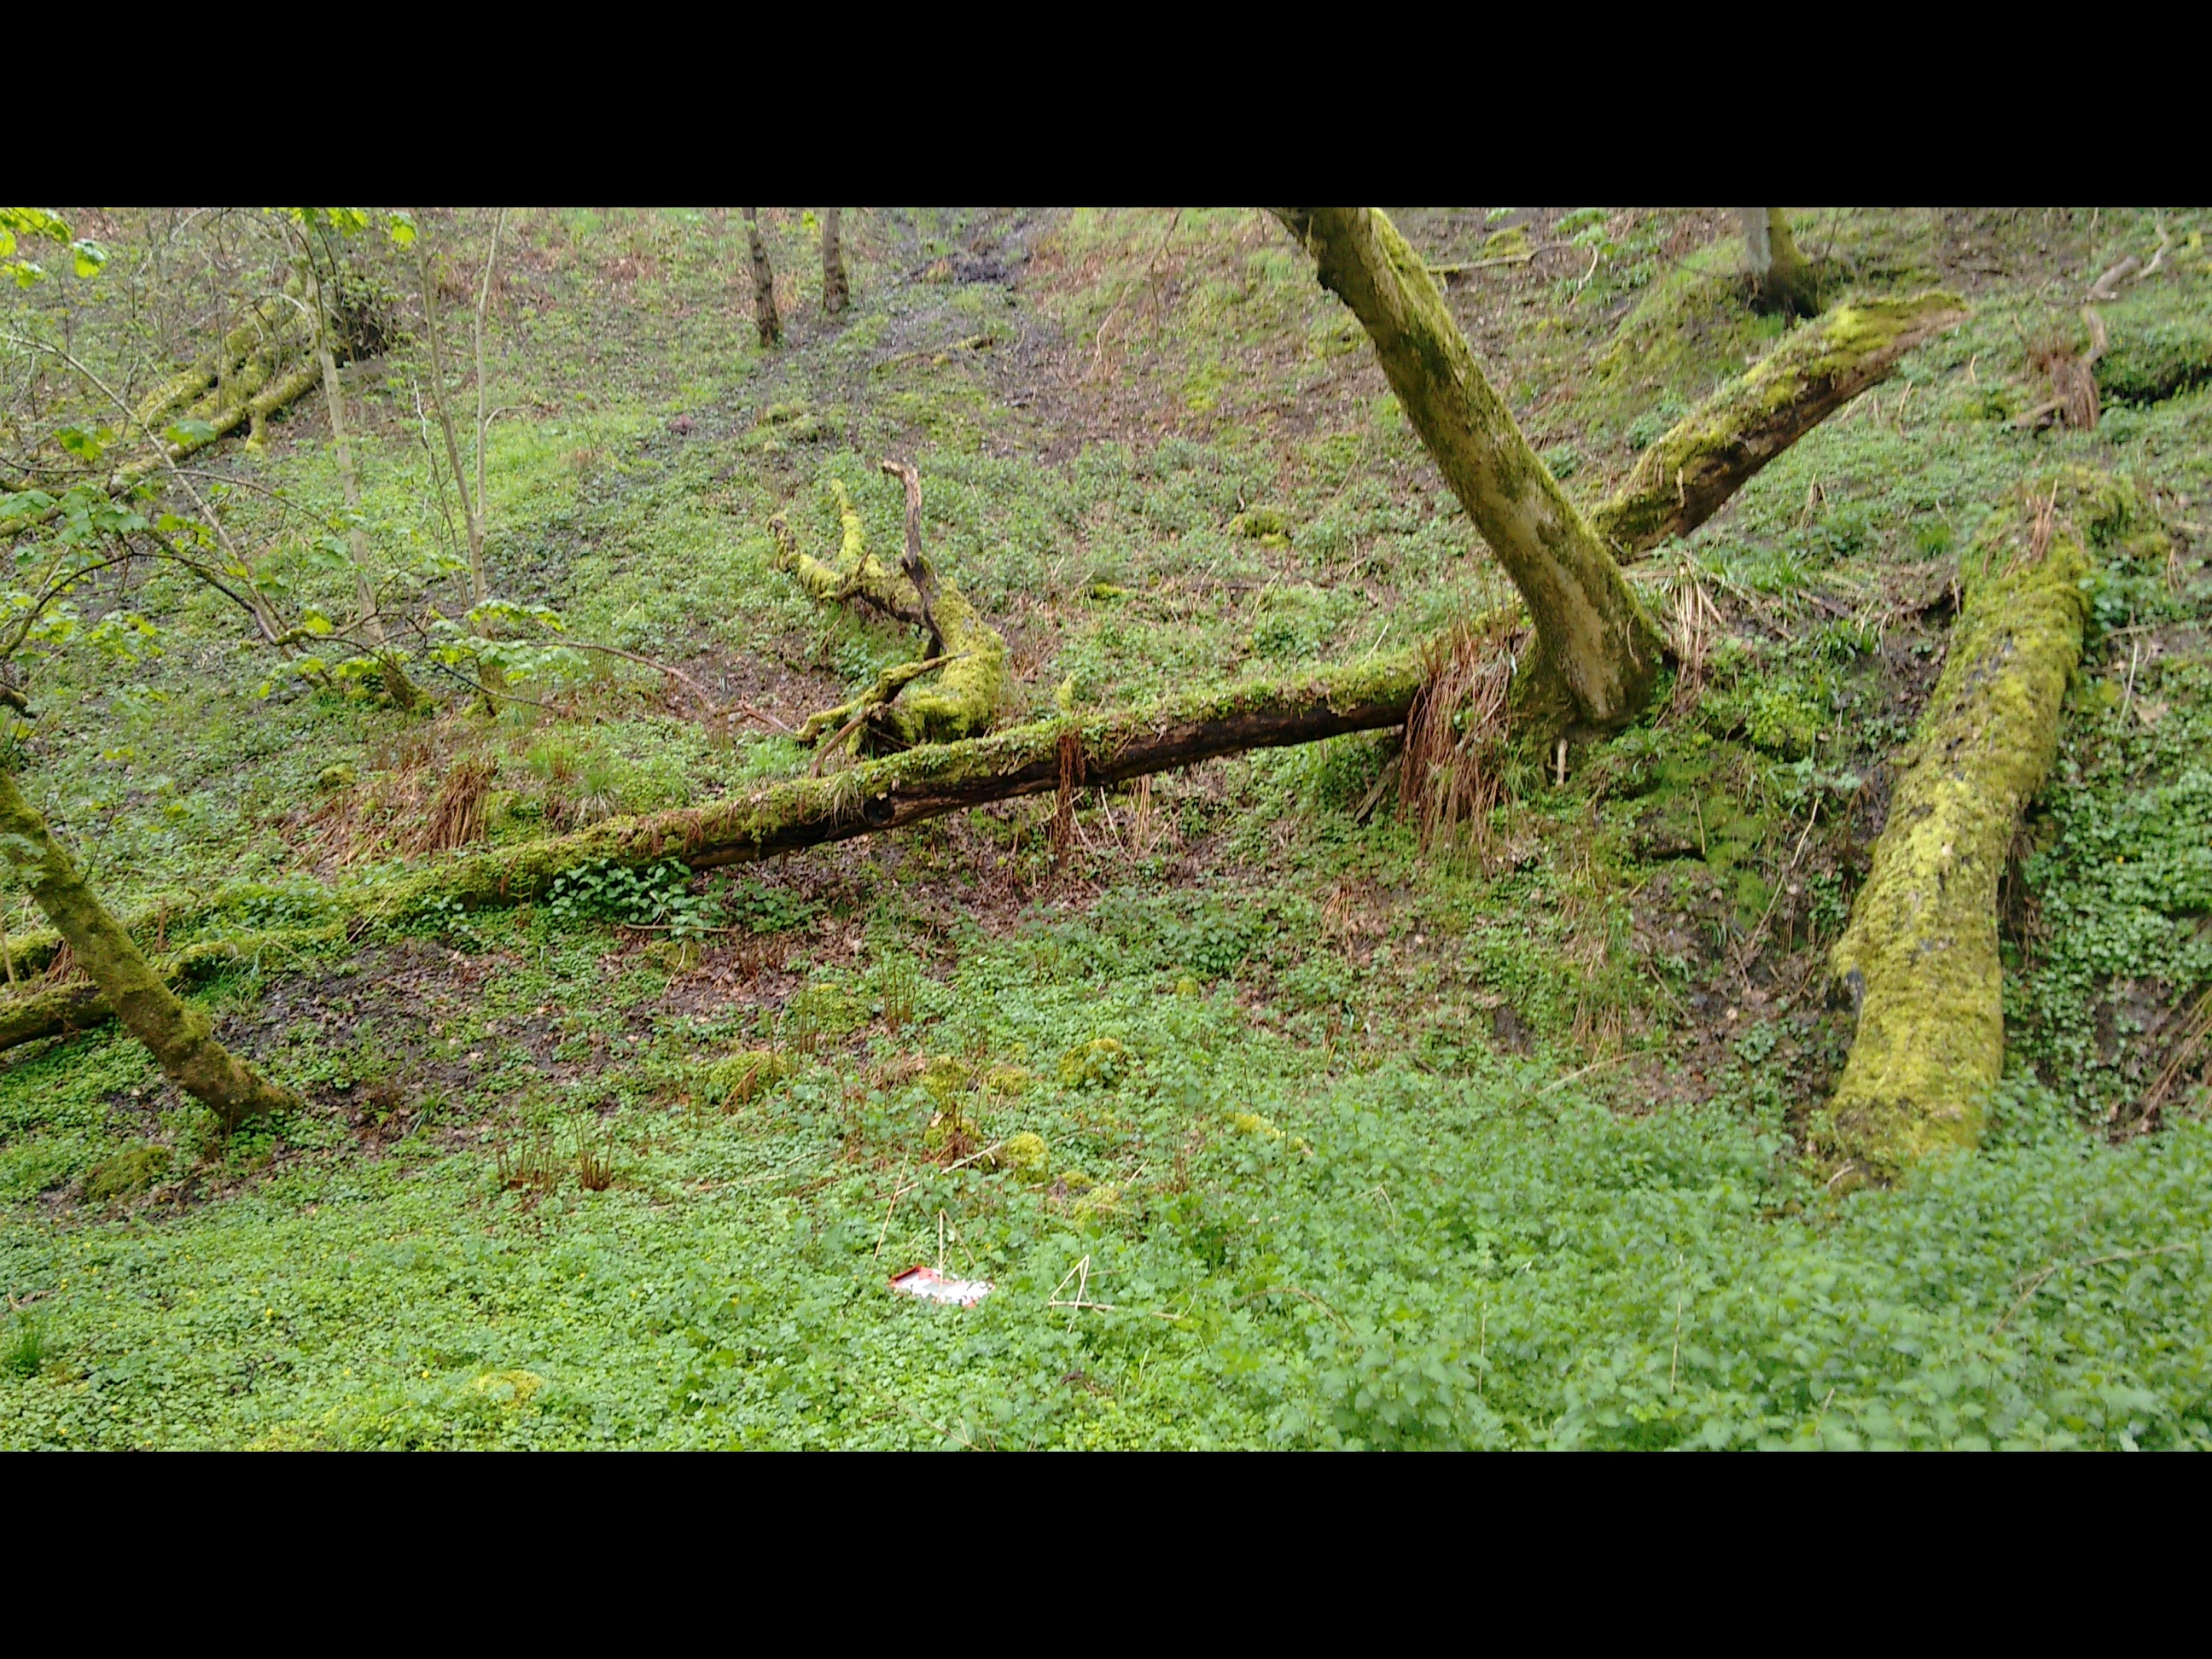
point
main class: Woodland
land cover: Broadleaved woodland
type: mesophytic deciduous forest
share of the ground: > 75 %
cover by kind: broadleaved forest trees 100 %
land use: Amenities, museums, leisure
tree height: > 5 m
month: May
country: GB
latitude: 53.7123
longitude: -2.5353
